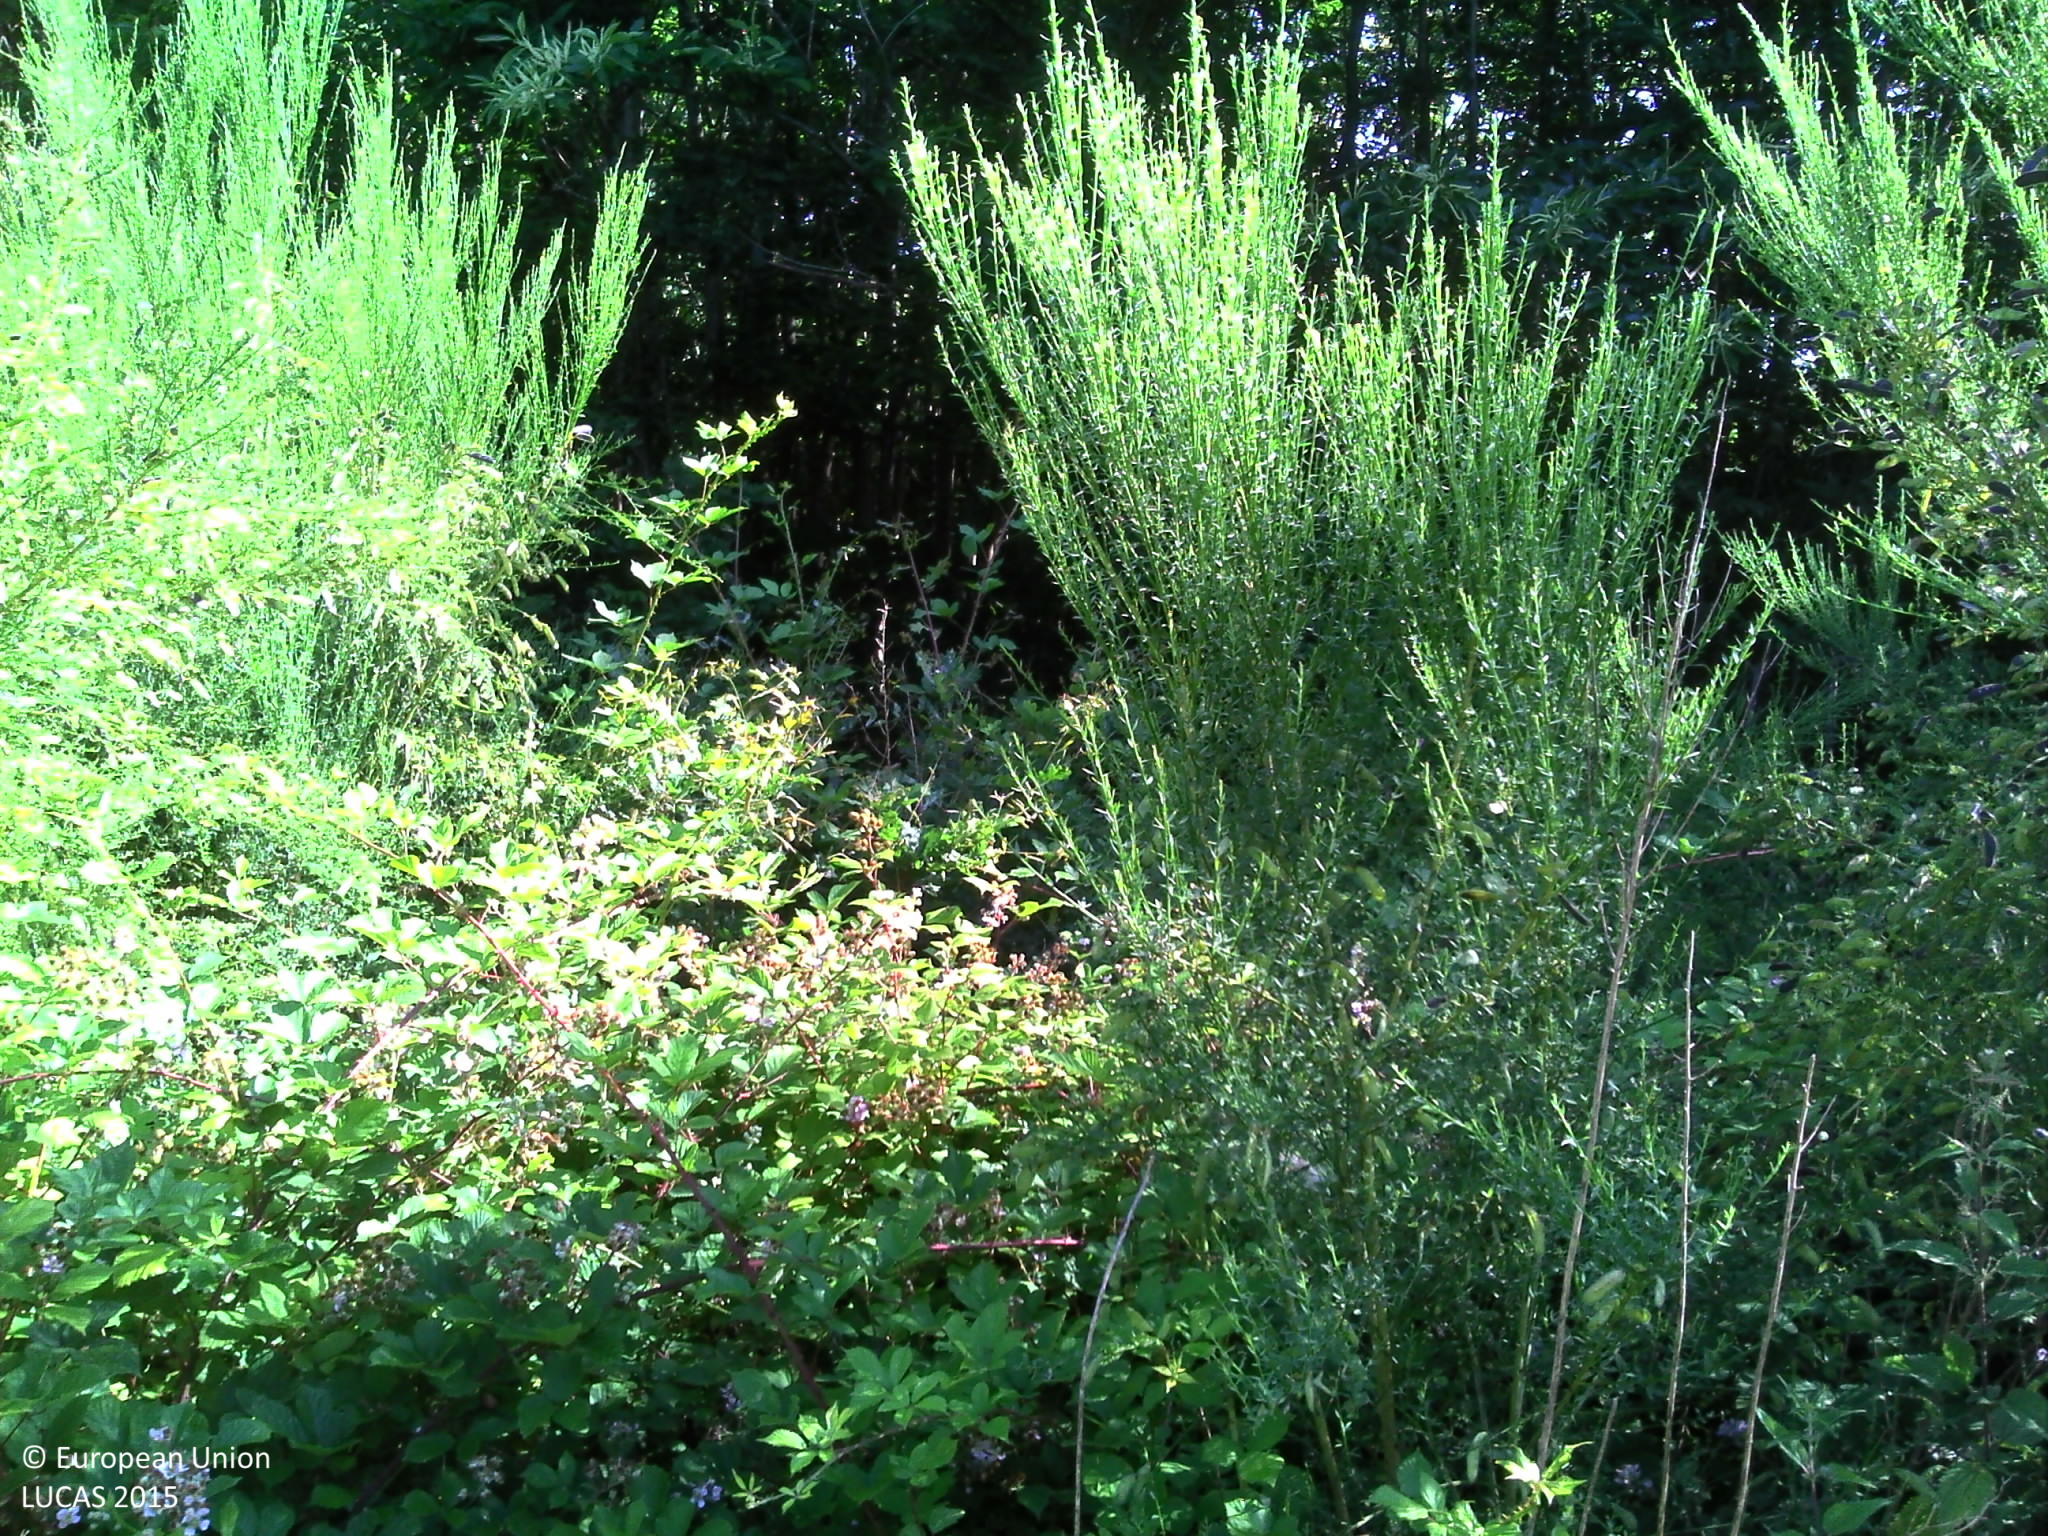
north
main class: Shrubland
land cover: Shrubland without tree cover
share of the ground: > 75 %
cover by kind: shrubs 100 %
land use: Semi-natural and natural areas not in use
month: June
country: FR
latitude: 47.1872
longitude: -1.9646
